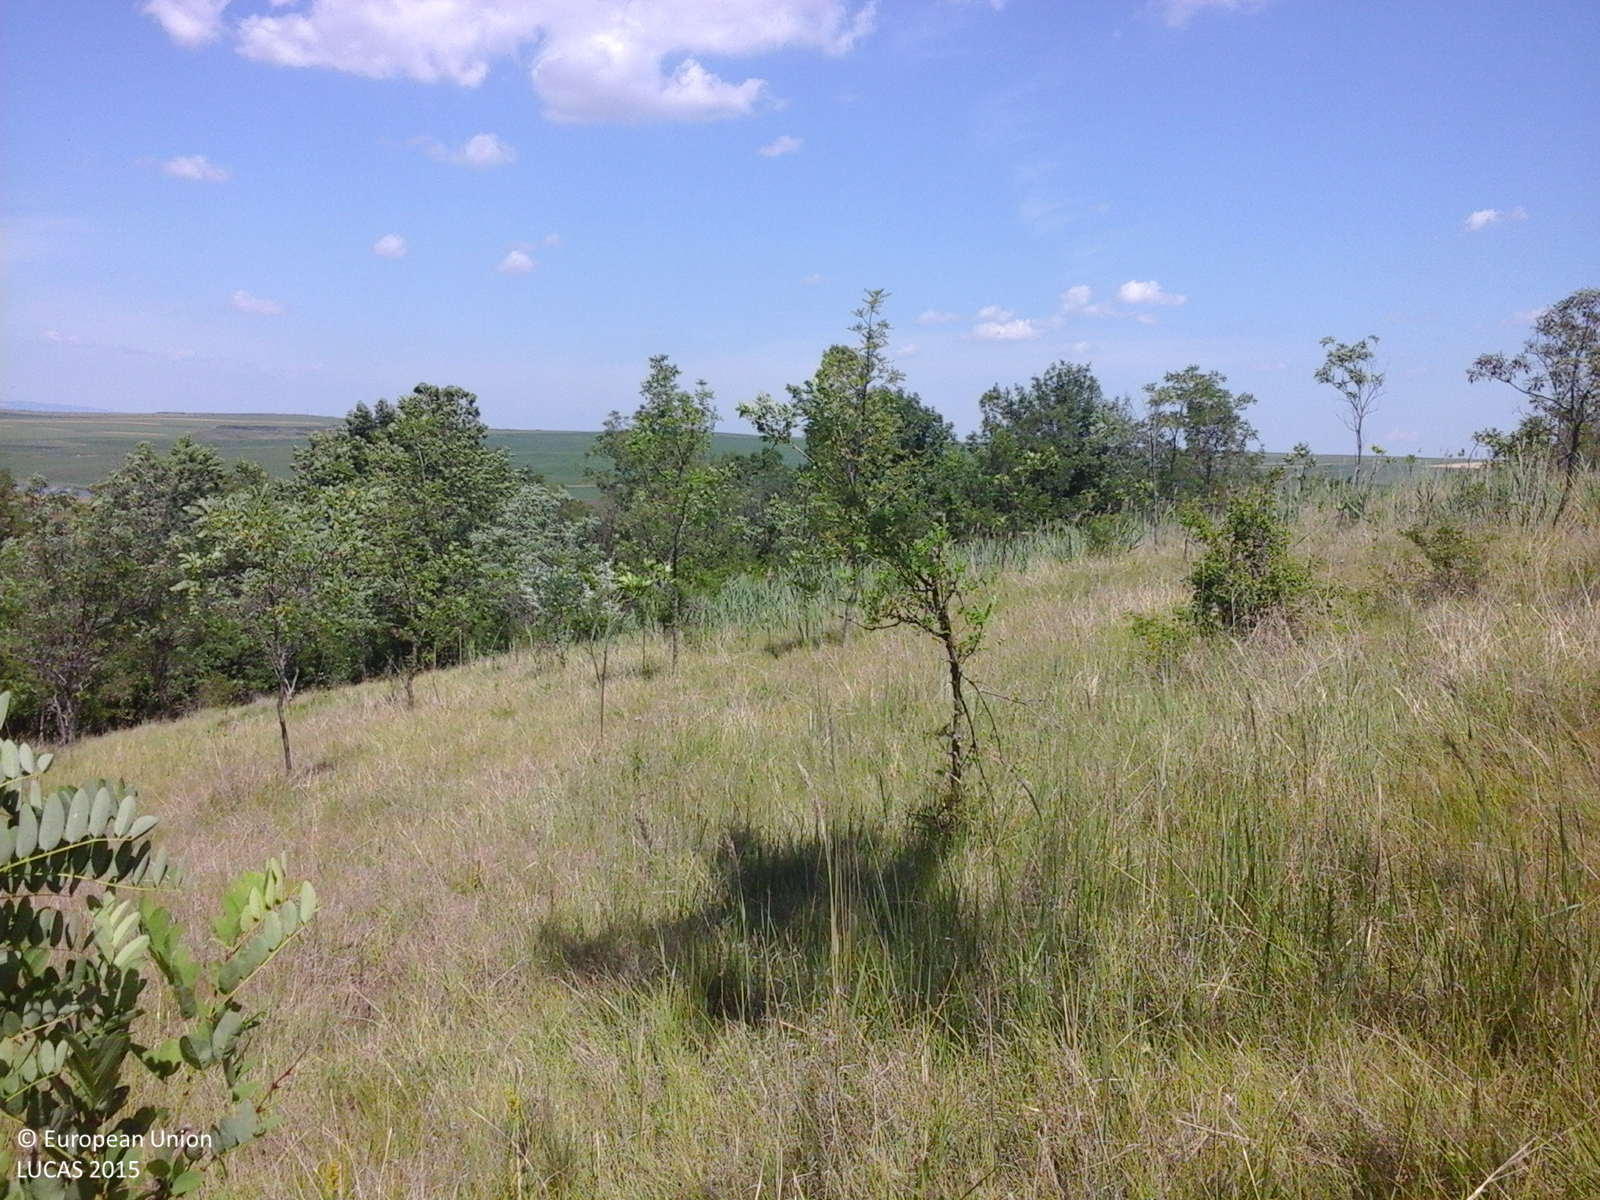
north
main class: Grassland
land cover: Grassland with sparse tree/shrub cover
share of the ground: > 75 %
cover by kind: herbaceous plants 90 %, broadleaved forest trees 5 %, shrubs 5 %
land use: Agriculture (excluding fallow land and kitchen gardens)
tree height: > 5 m
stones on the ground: < 10 %
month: June
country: RO
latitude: 47.2367
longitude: 27.1322
